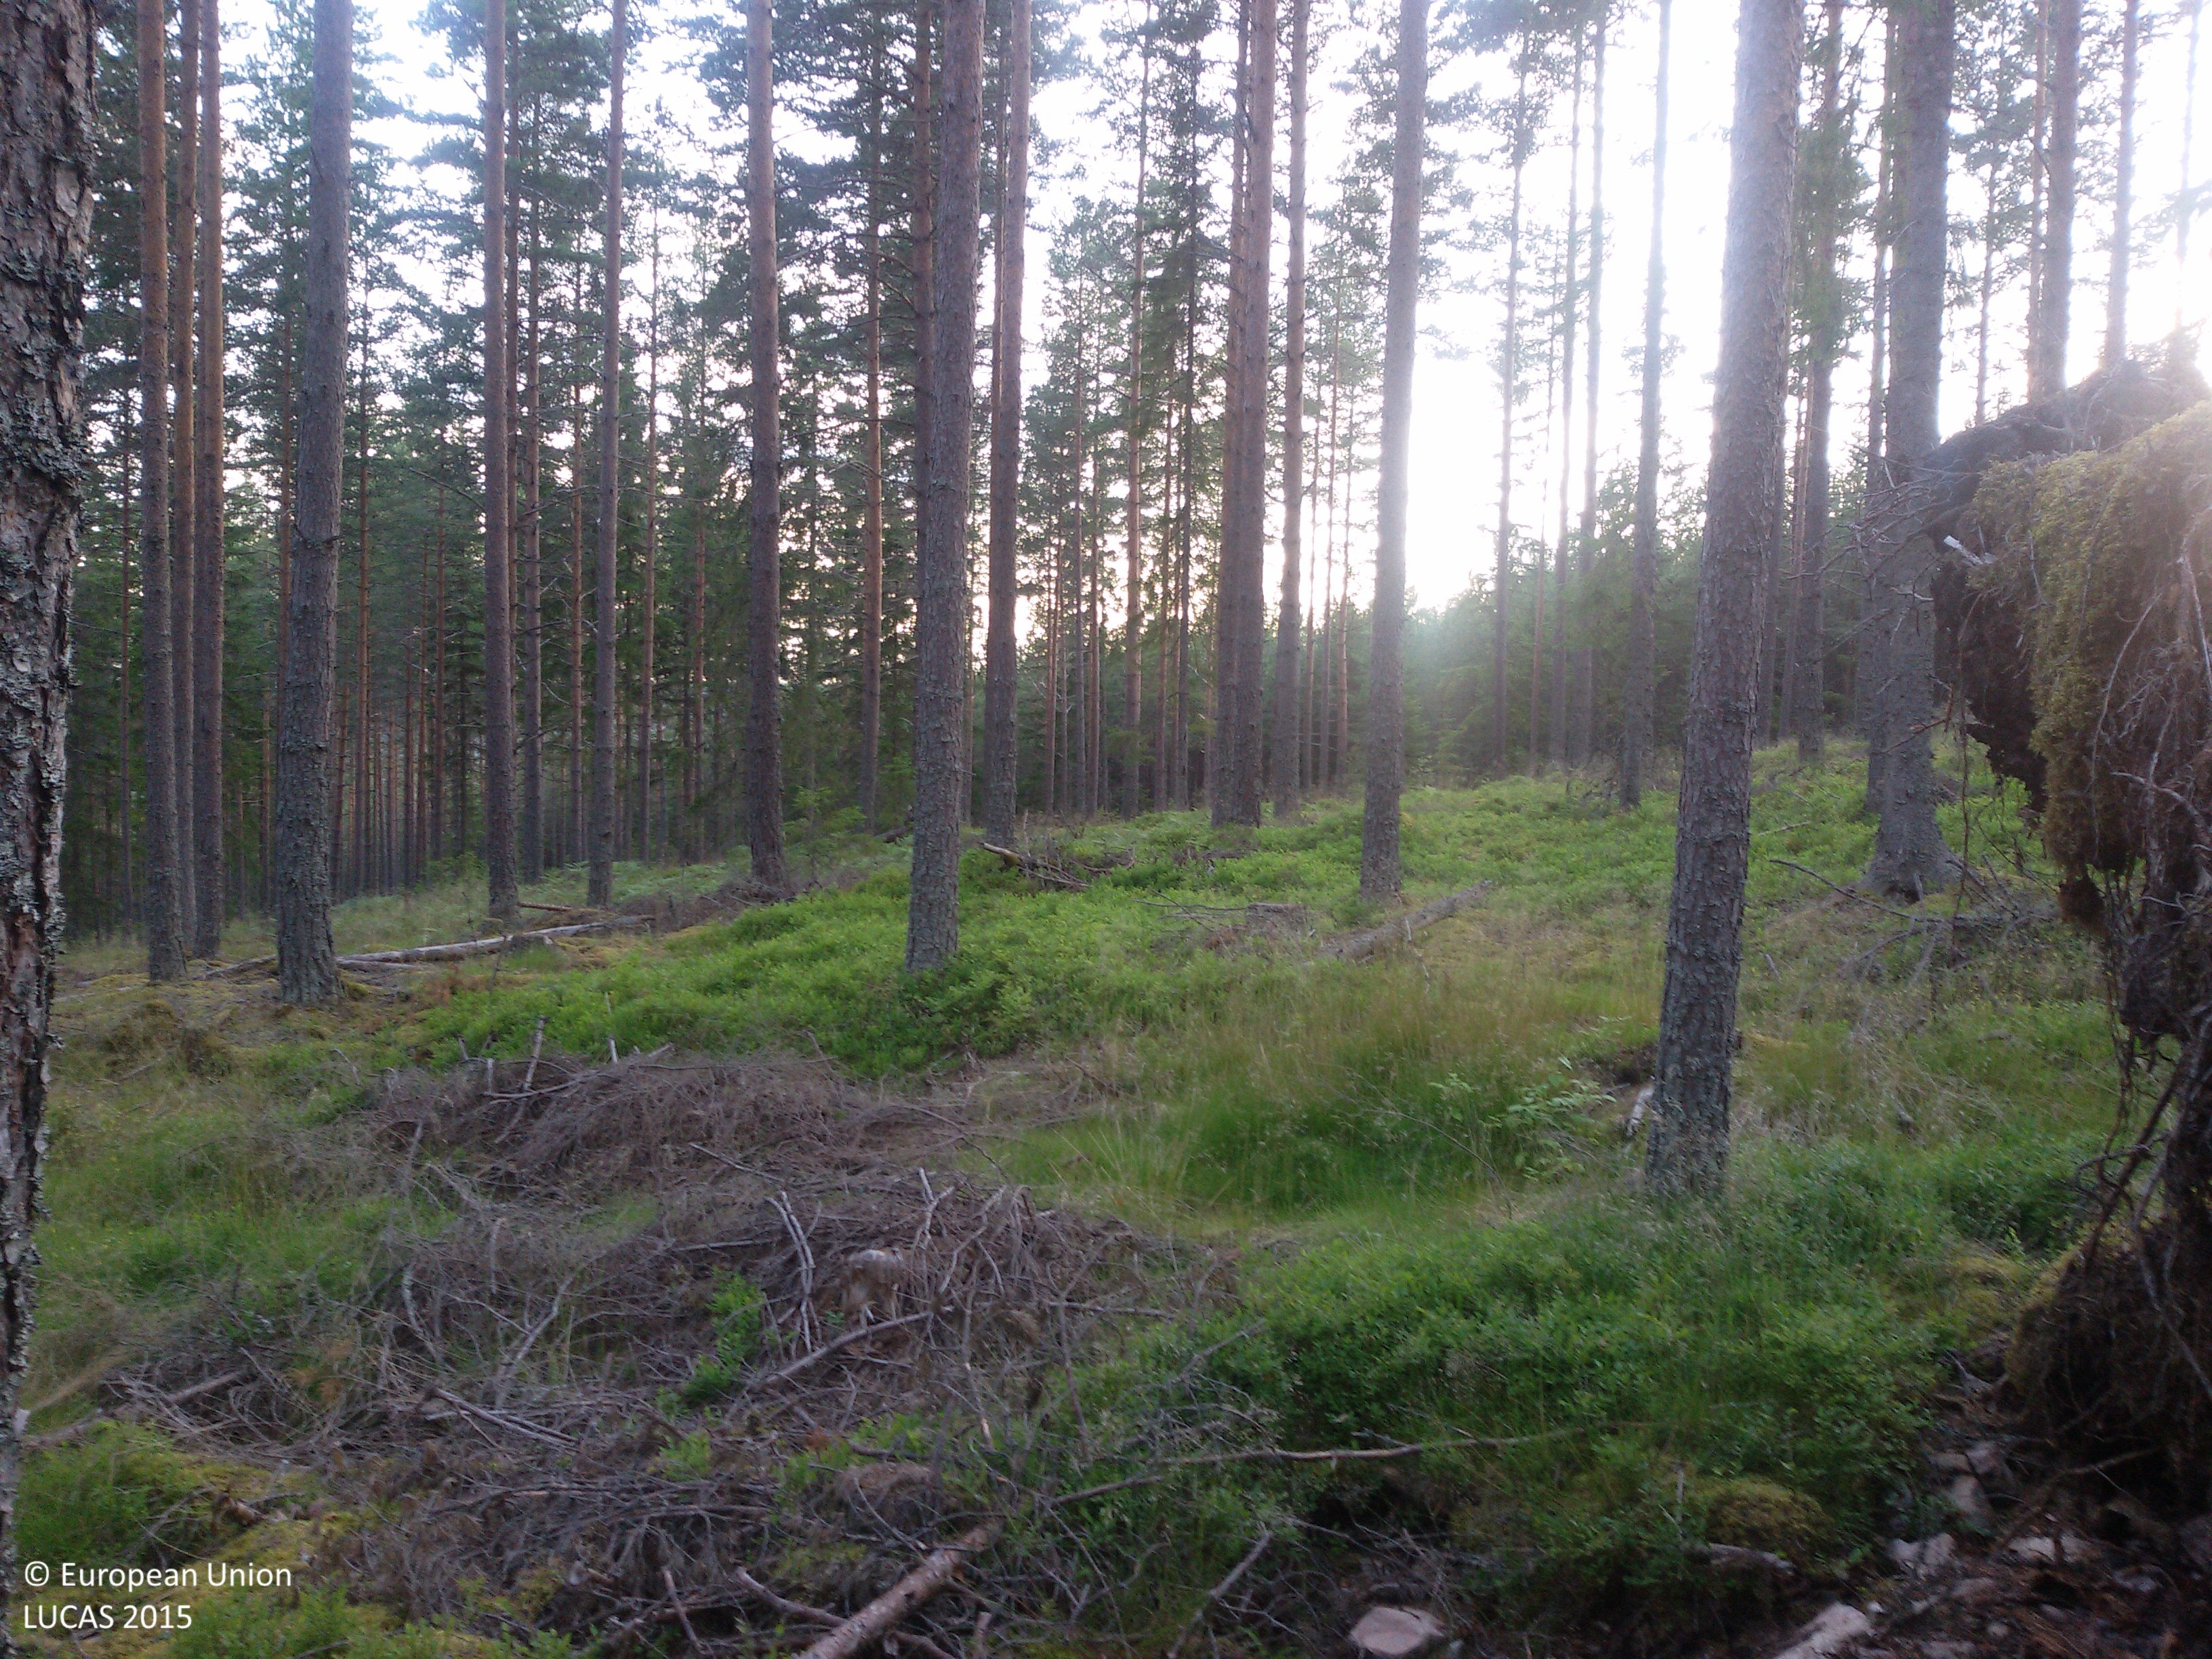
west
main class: Woodland
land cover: Pine dominated coniferous woodland
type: boreal forest
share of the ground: 50 - 75 %
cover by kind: coniferous forest trees 75 %, lichens and mosses 20 %, herbaceous plants 5 %
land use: Forestry
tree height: > 5 m
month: July
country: SE
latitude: 60.5264
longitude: 14.9619
